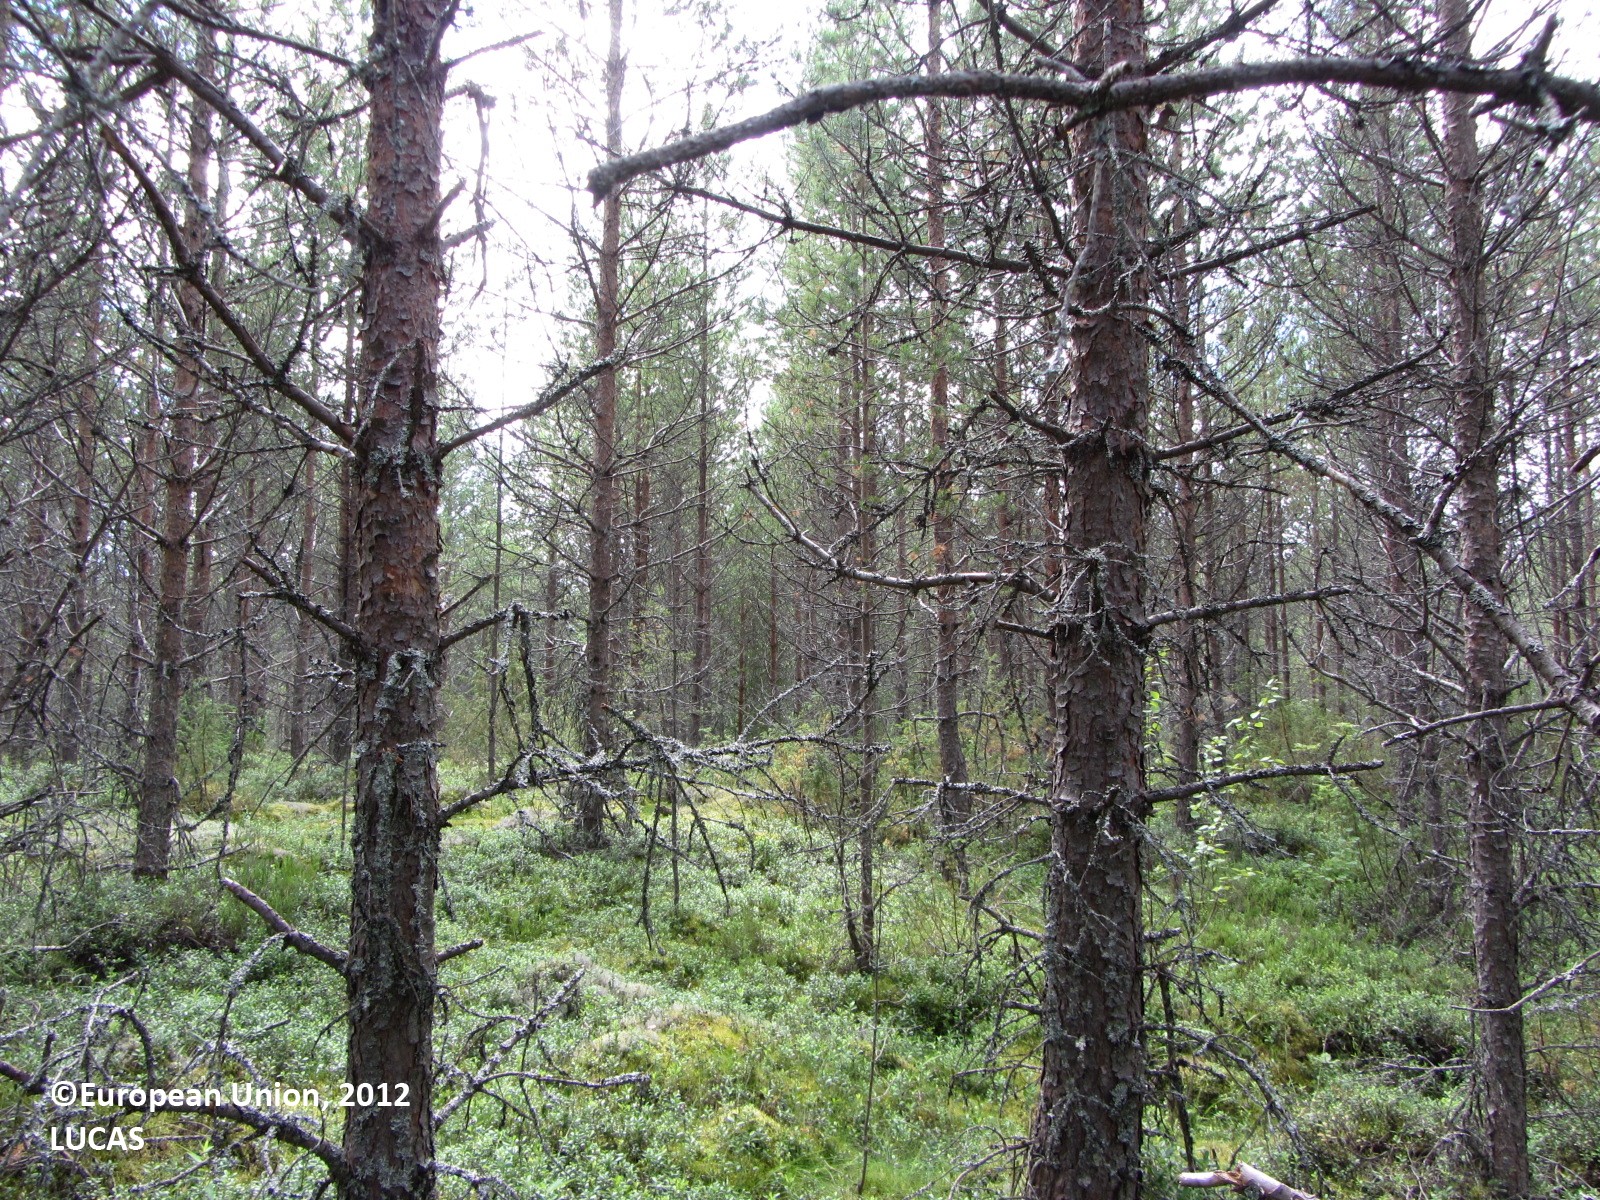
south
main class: Woodland
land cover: Pine dominated coniferous woodland
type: boreal forest
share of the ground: > 75 %
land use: Forestry
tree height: > 5 m
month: July
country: FI
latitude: 63.6029
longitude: 25.3997
